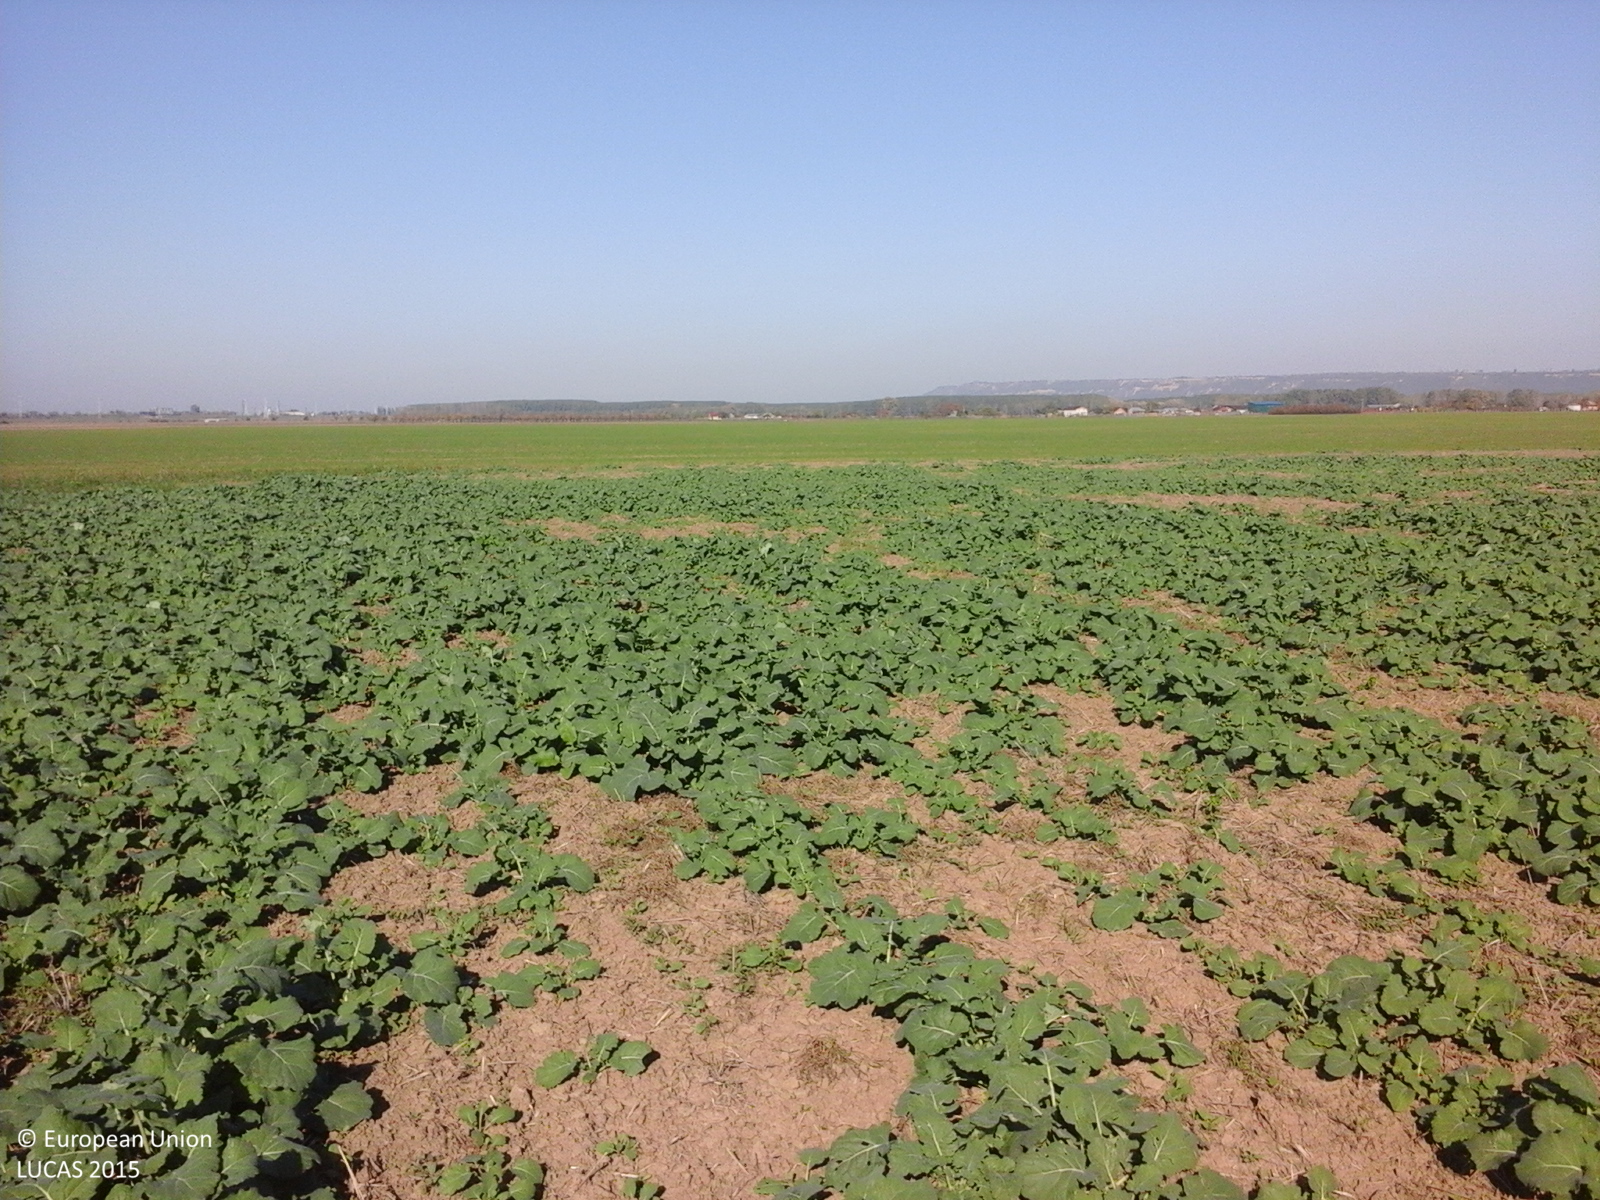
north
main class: Cropland
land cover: Rape and turnip rape
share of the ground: > 75 %
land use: Agriculture (excluding fallow land and kitchen gardens)
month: October
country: RO
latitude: 45.8969
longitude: 27.2265
